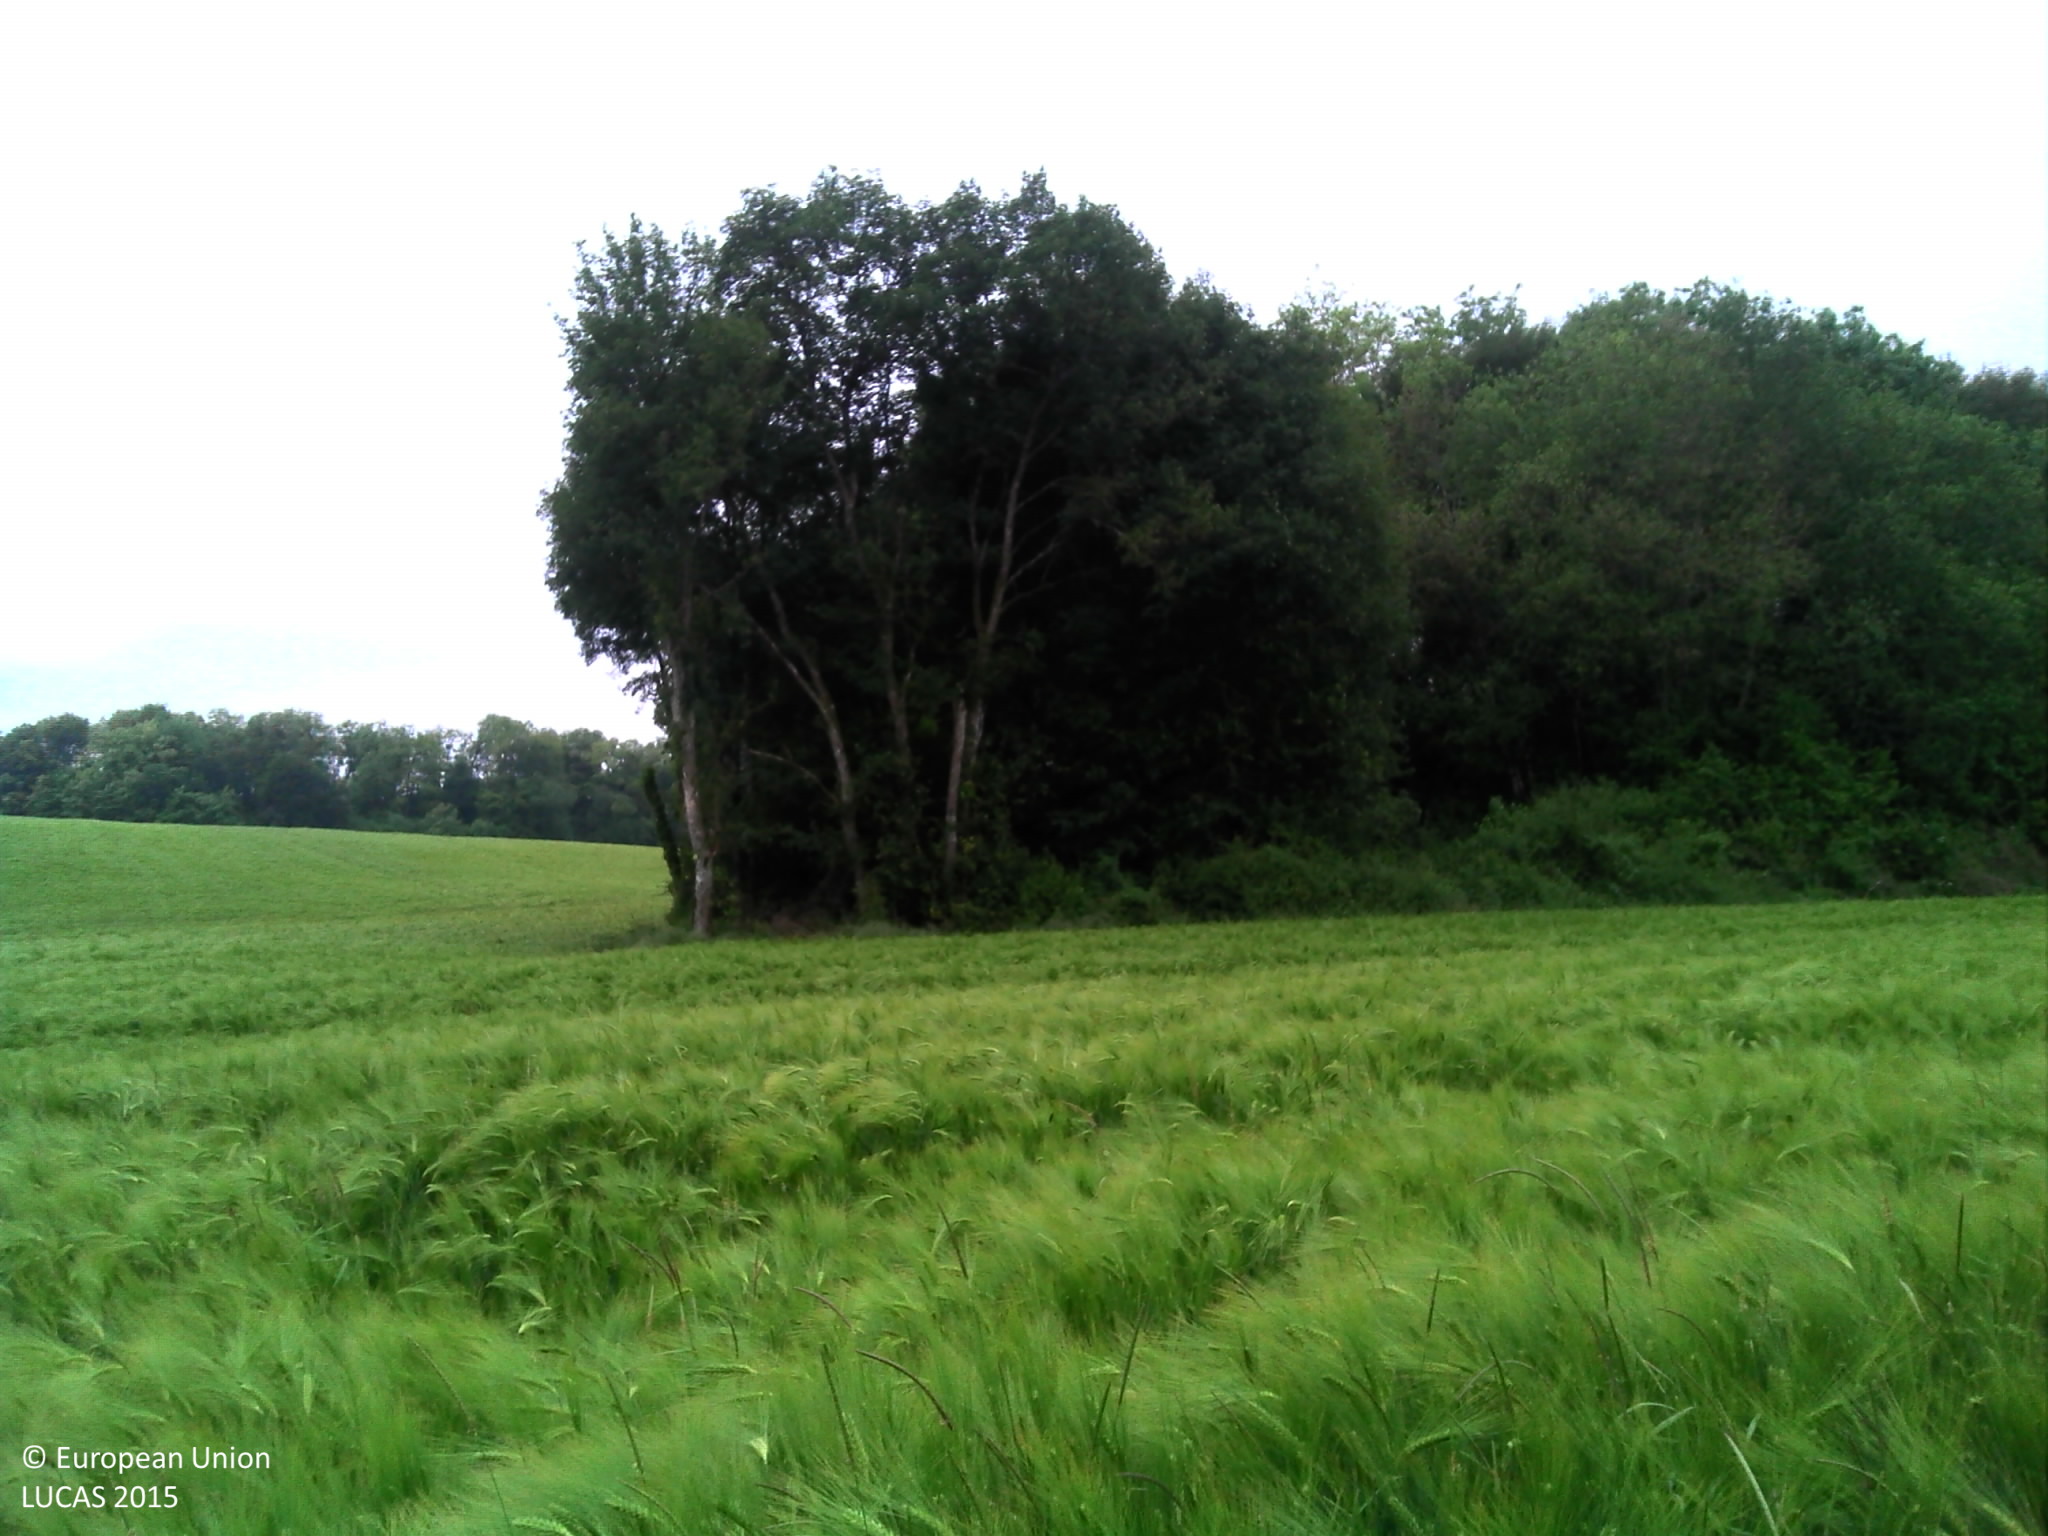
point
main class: Cropland
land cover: Barley
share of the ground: > 75 %
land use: Agriculture (excluding fallow land and kitchen gardens)
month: May
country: FR
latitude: 47.9026
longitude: 6.1080
